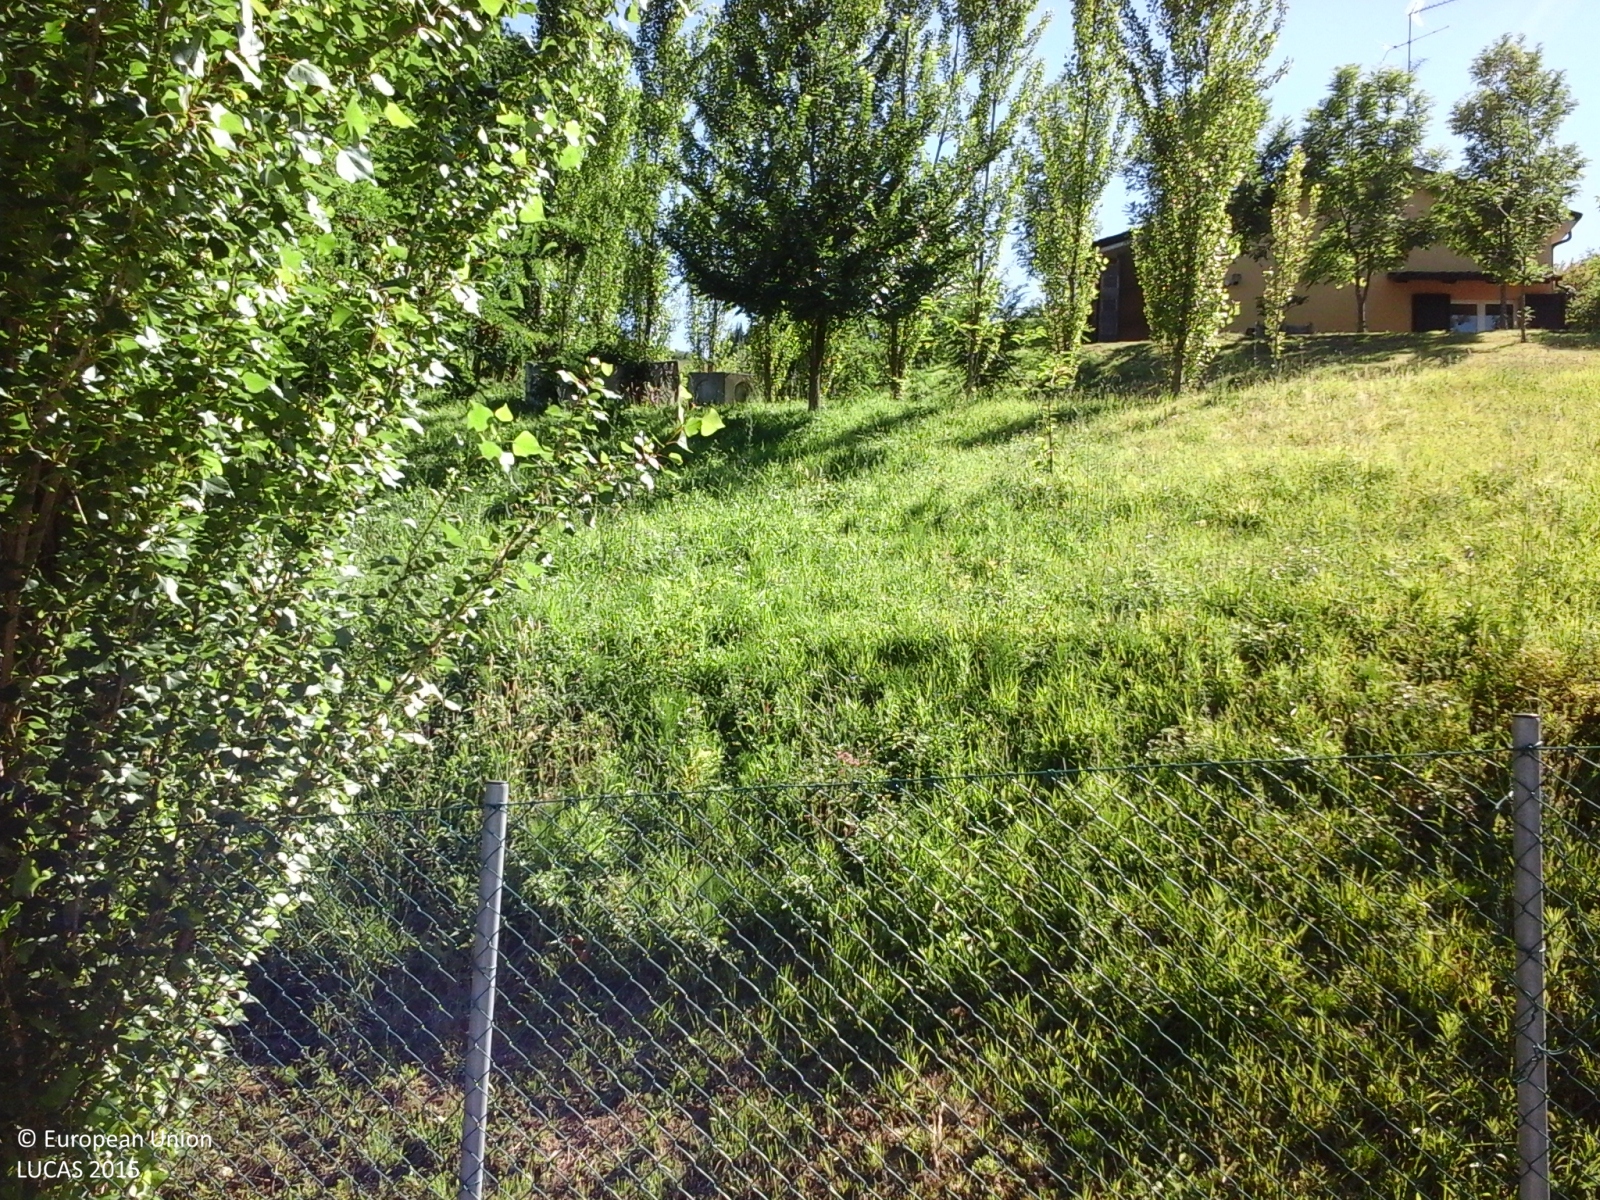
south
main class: Grassland
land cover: Grassland with sparse tree/shrub cover
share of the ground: > 75 %
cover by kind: herbaceous plants 95 %, broadleaved forest trees 5 %
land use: Residential
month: June
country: IT
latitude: 44.2663
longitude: 11.5873
